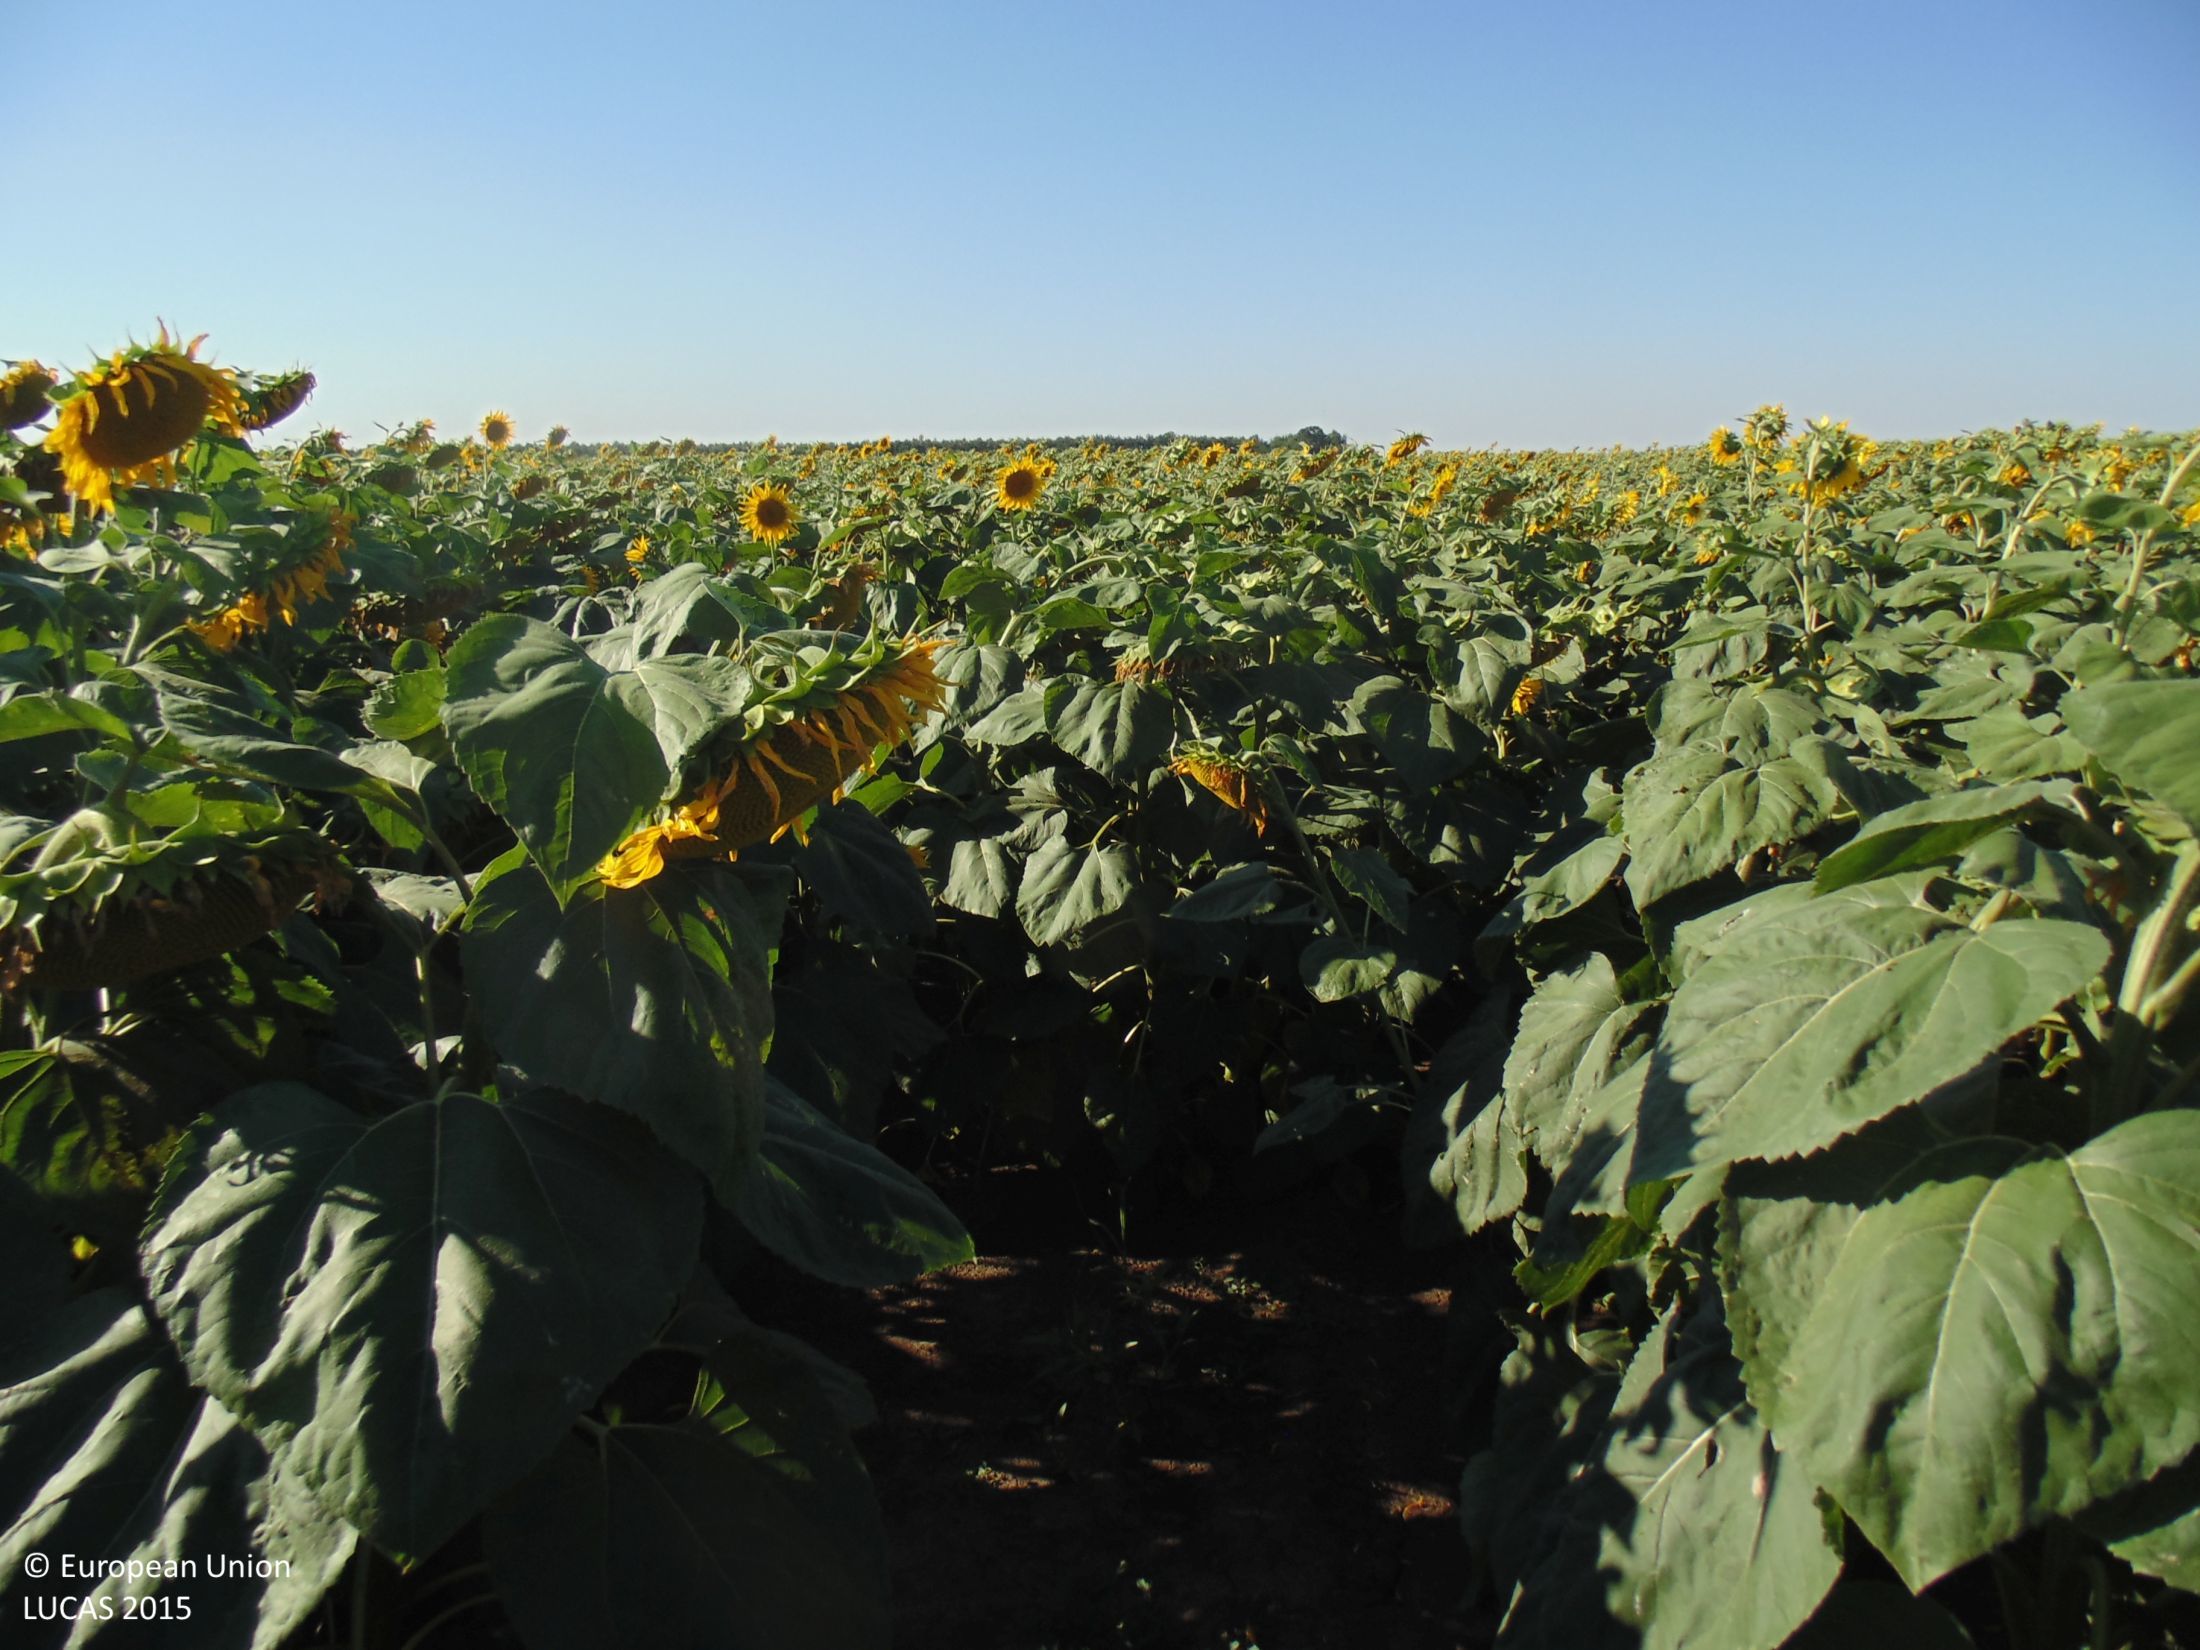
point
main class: Cropland
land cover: Sunflower
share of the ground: > 75 %
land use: Agriculture (excluding fallow land and kitchen gardens)
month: July
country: BG
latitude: 43.4520
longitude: 28.0528
